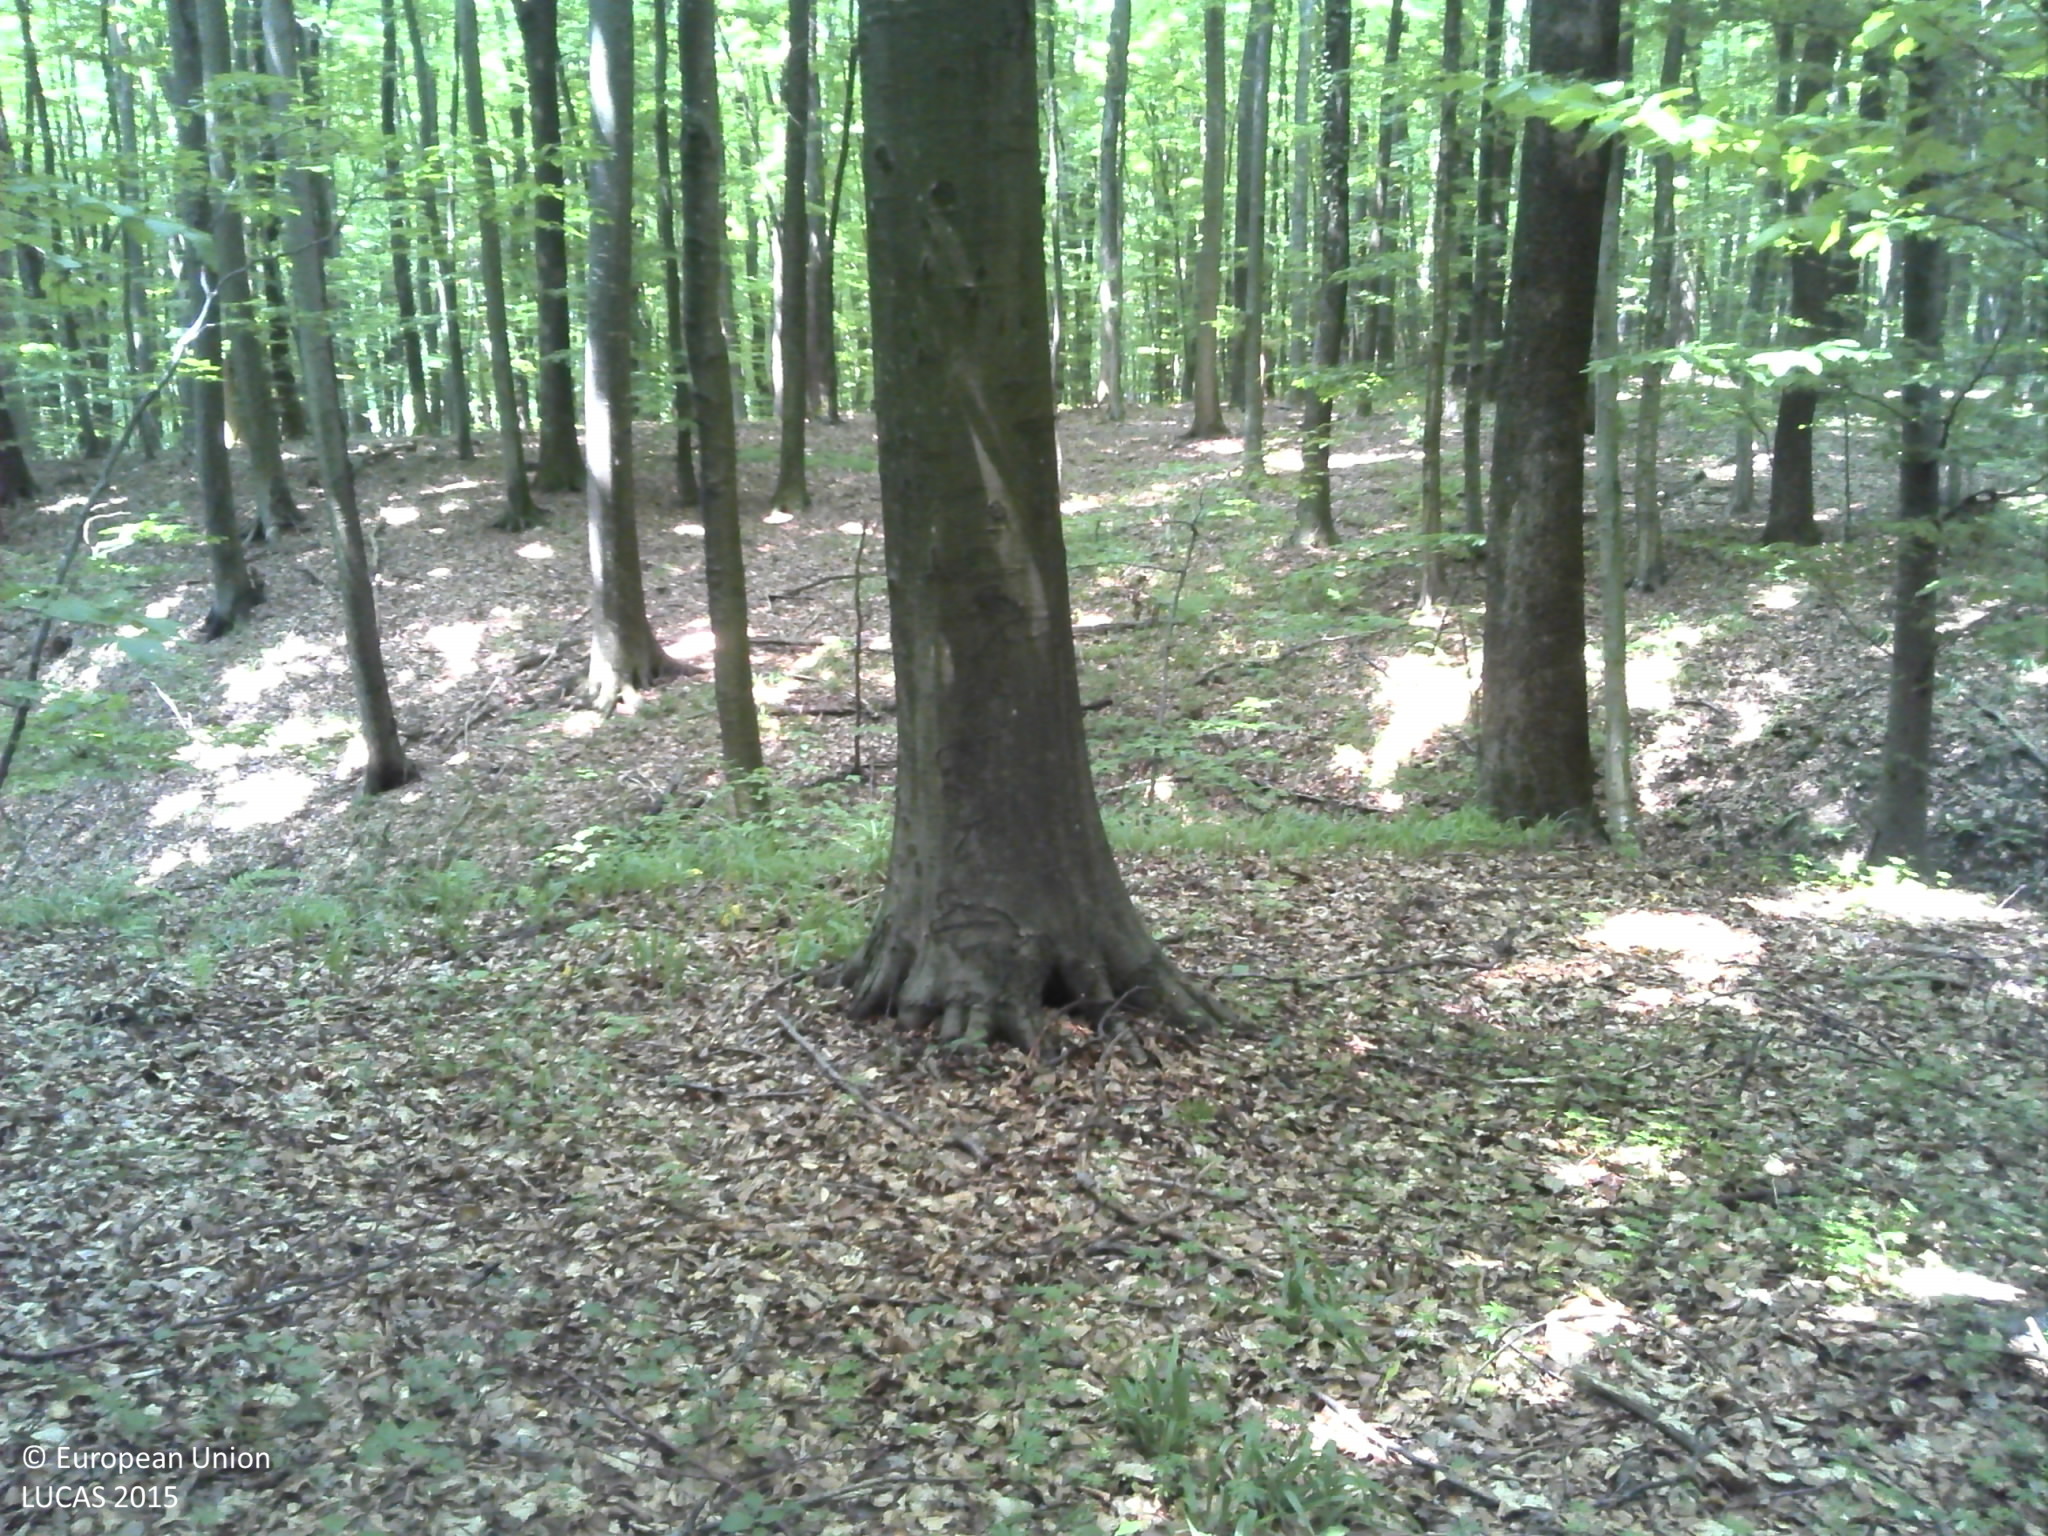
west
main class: Woodland
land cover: Broadleaved woodland
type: acidophilous oak and oak-birch forest
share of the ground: > 75 %
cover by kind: broadleaved forest trees 95 %, herbaceous plants 5 %
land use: Forestry
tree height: > 5 m
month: July
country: HR
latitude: 46.0762
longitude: 16.8670
